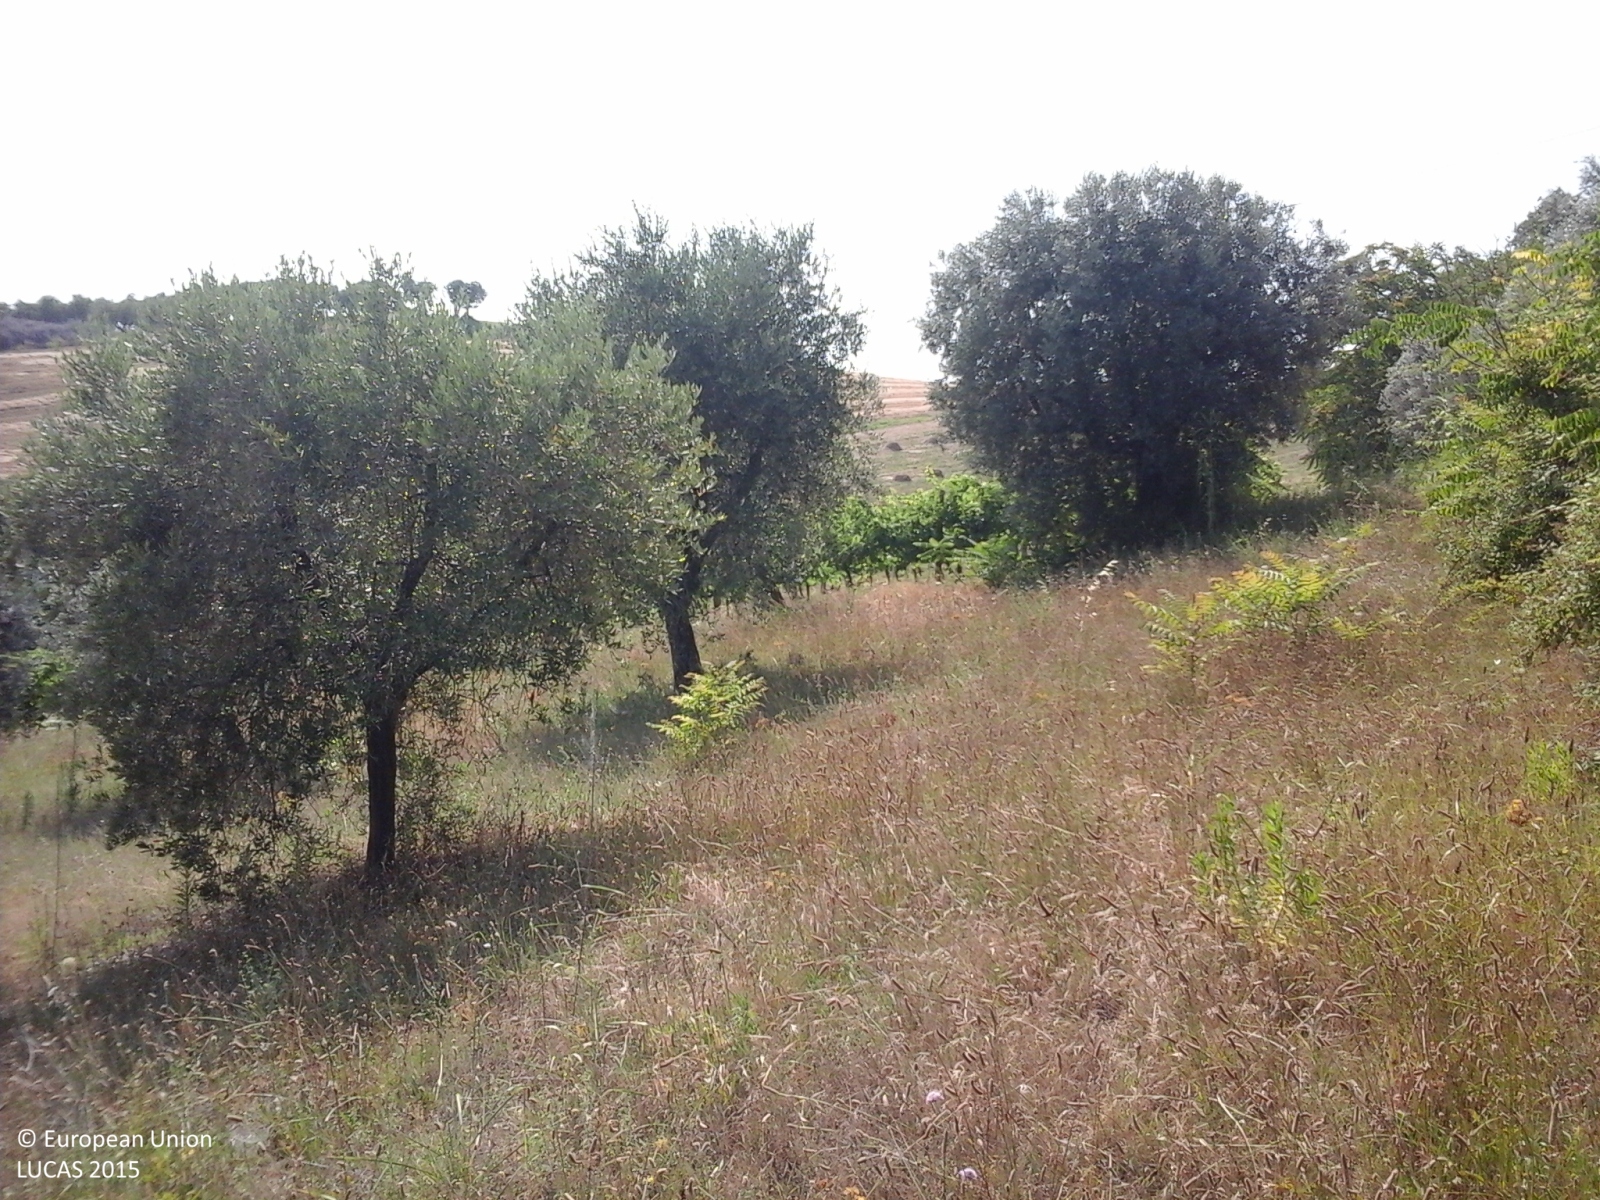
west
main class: Cropland
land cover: Olive groves
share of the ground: 10 - 25 %
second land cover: Grassland without tree/shrub cover
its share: 50 - 75 %
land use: Agriculture (excluding fallow land and kitchen gardens)
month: July
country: IT
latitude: 43.0515
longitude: 13.8326
